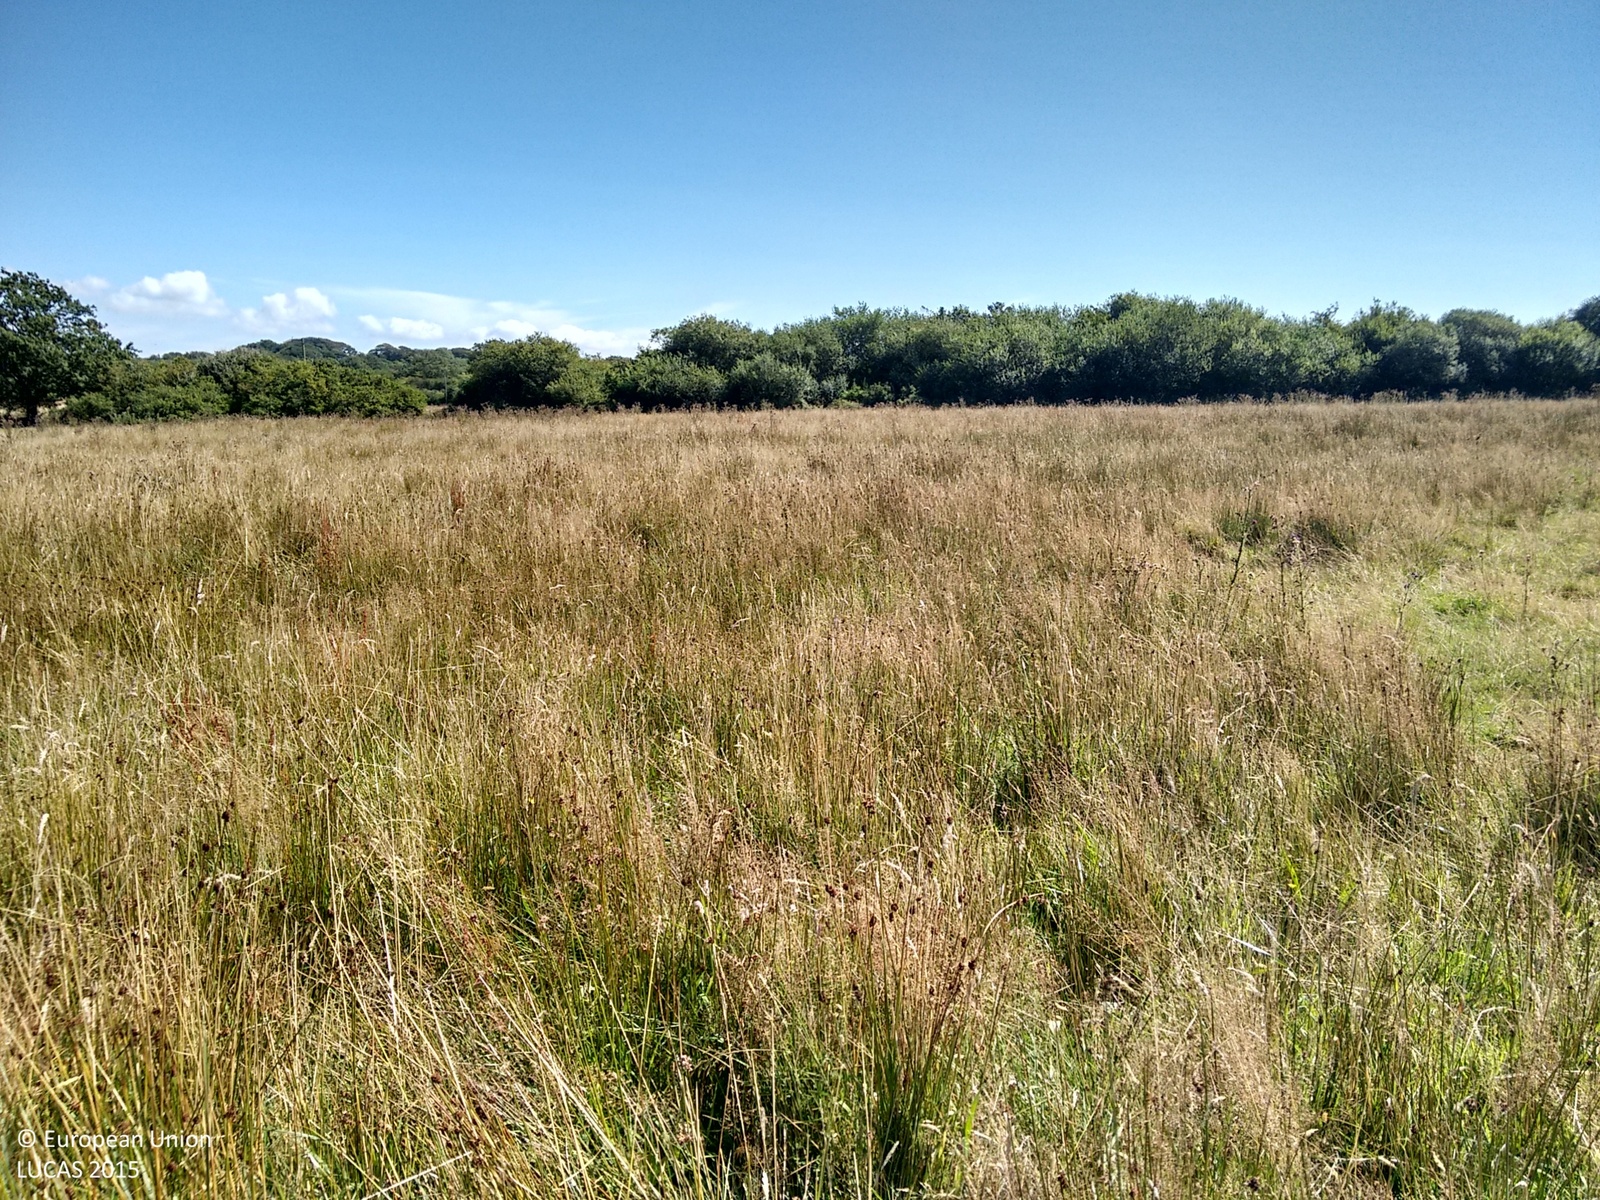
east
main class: Grassland
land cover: Grassland without tree/shrub cover
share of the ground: > 75 %
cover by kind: herbaceous plants 100 %
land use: Agriculture (excluding fallow land and kitchen gardens)
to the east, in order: Grassland without tree/shrub cover; Abandoned hedges; Rivers and streams; Grassland without tree/shrub cover; Managed hedges; Lines of trees; Ditches and canals; Grass margins; Paved roads, cycling and walking lanes; Grass margins; Ditches and canals; Managed hedges; Shrubland with sparse tree cover
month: August
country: GB
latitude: 51.7129
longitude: -4.8323
